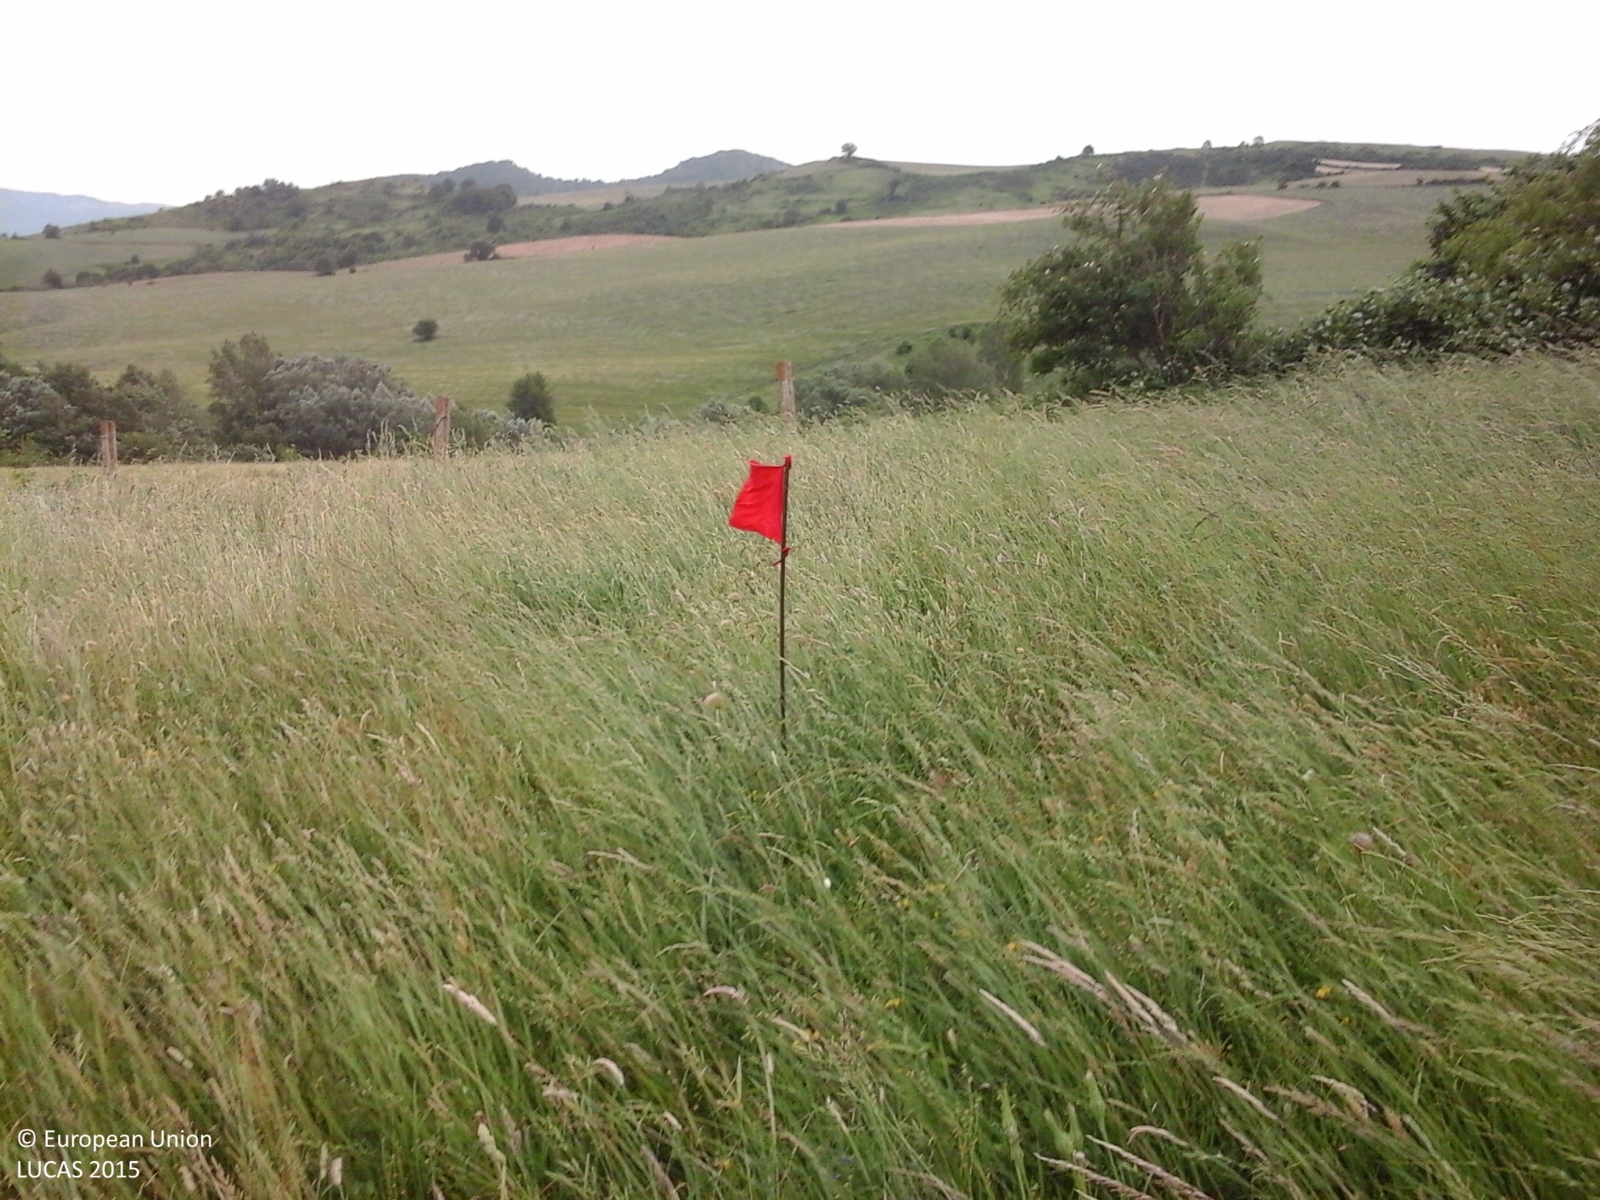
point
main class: Cropland
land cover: Other leguminous and mixtures for fodder
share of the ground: > 75 %
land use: Agriculture (excluding fallow land and kitchen gardens)
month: June
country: IT
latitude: 41.9661
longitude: 14.2936
